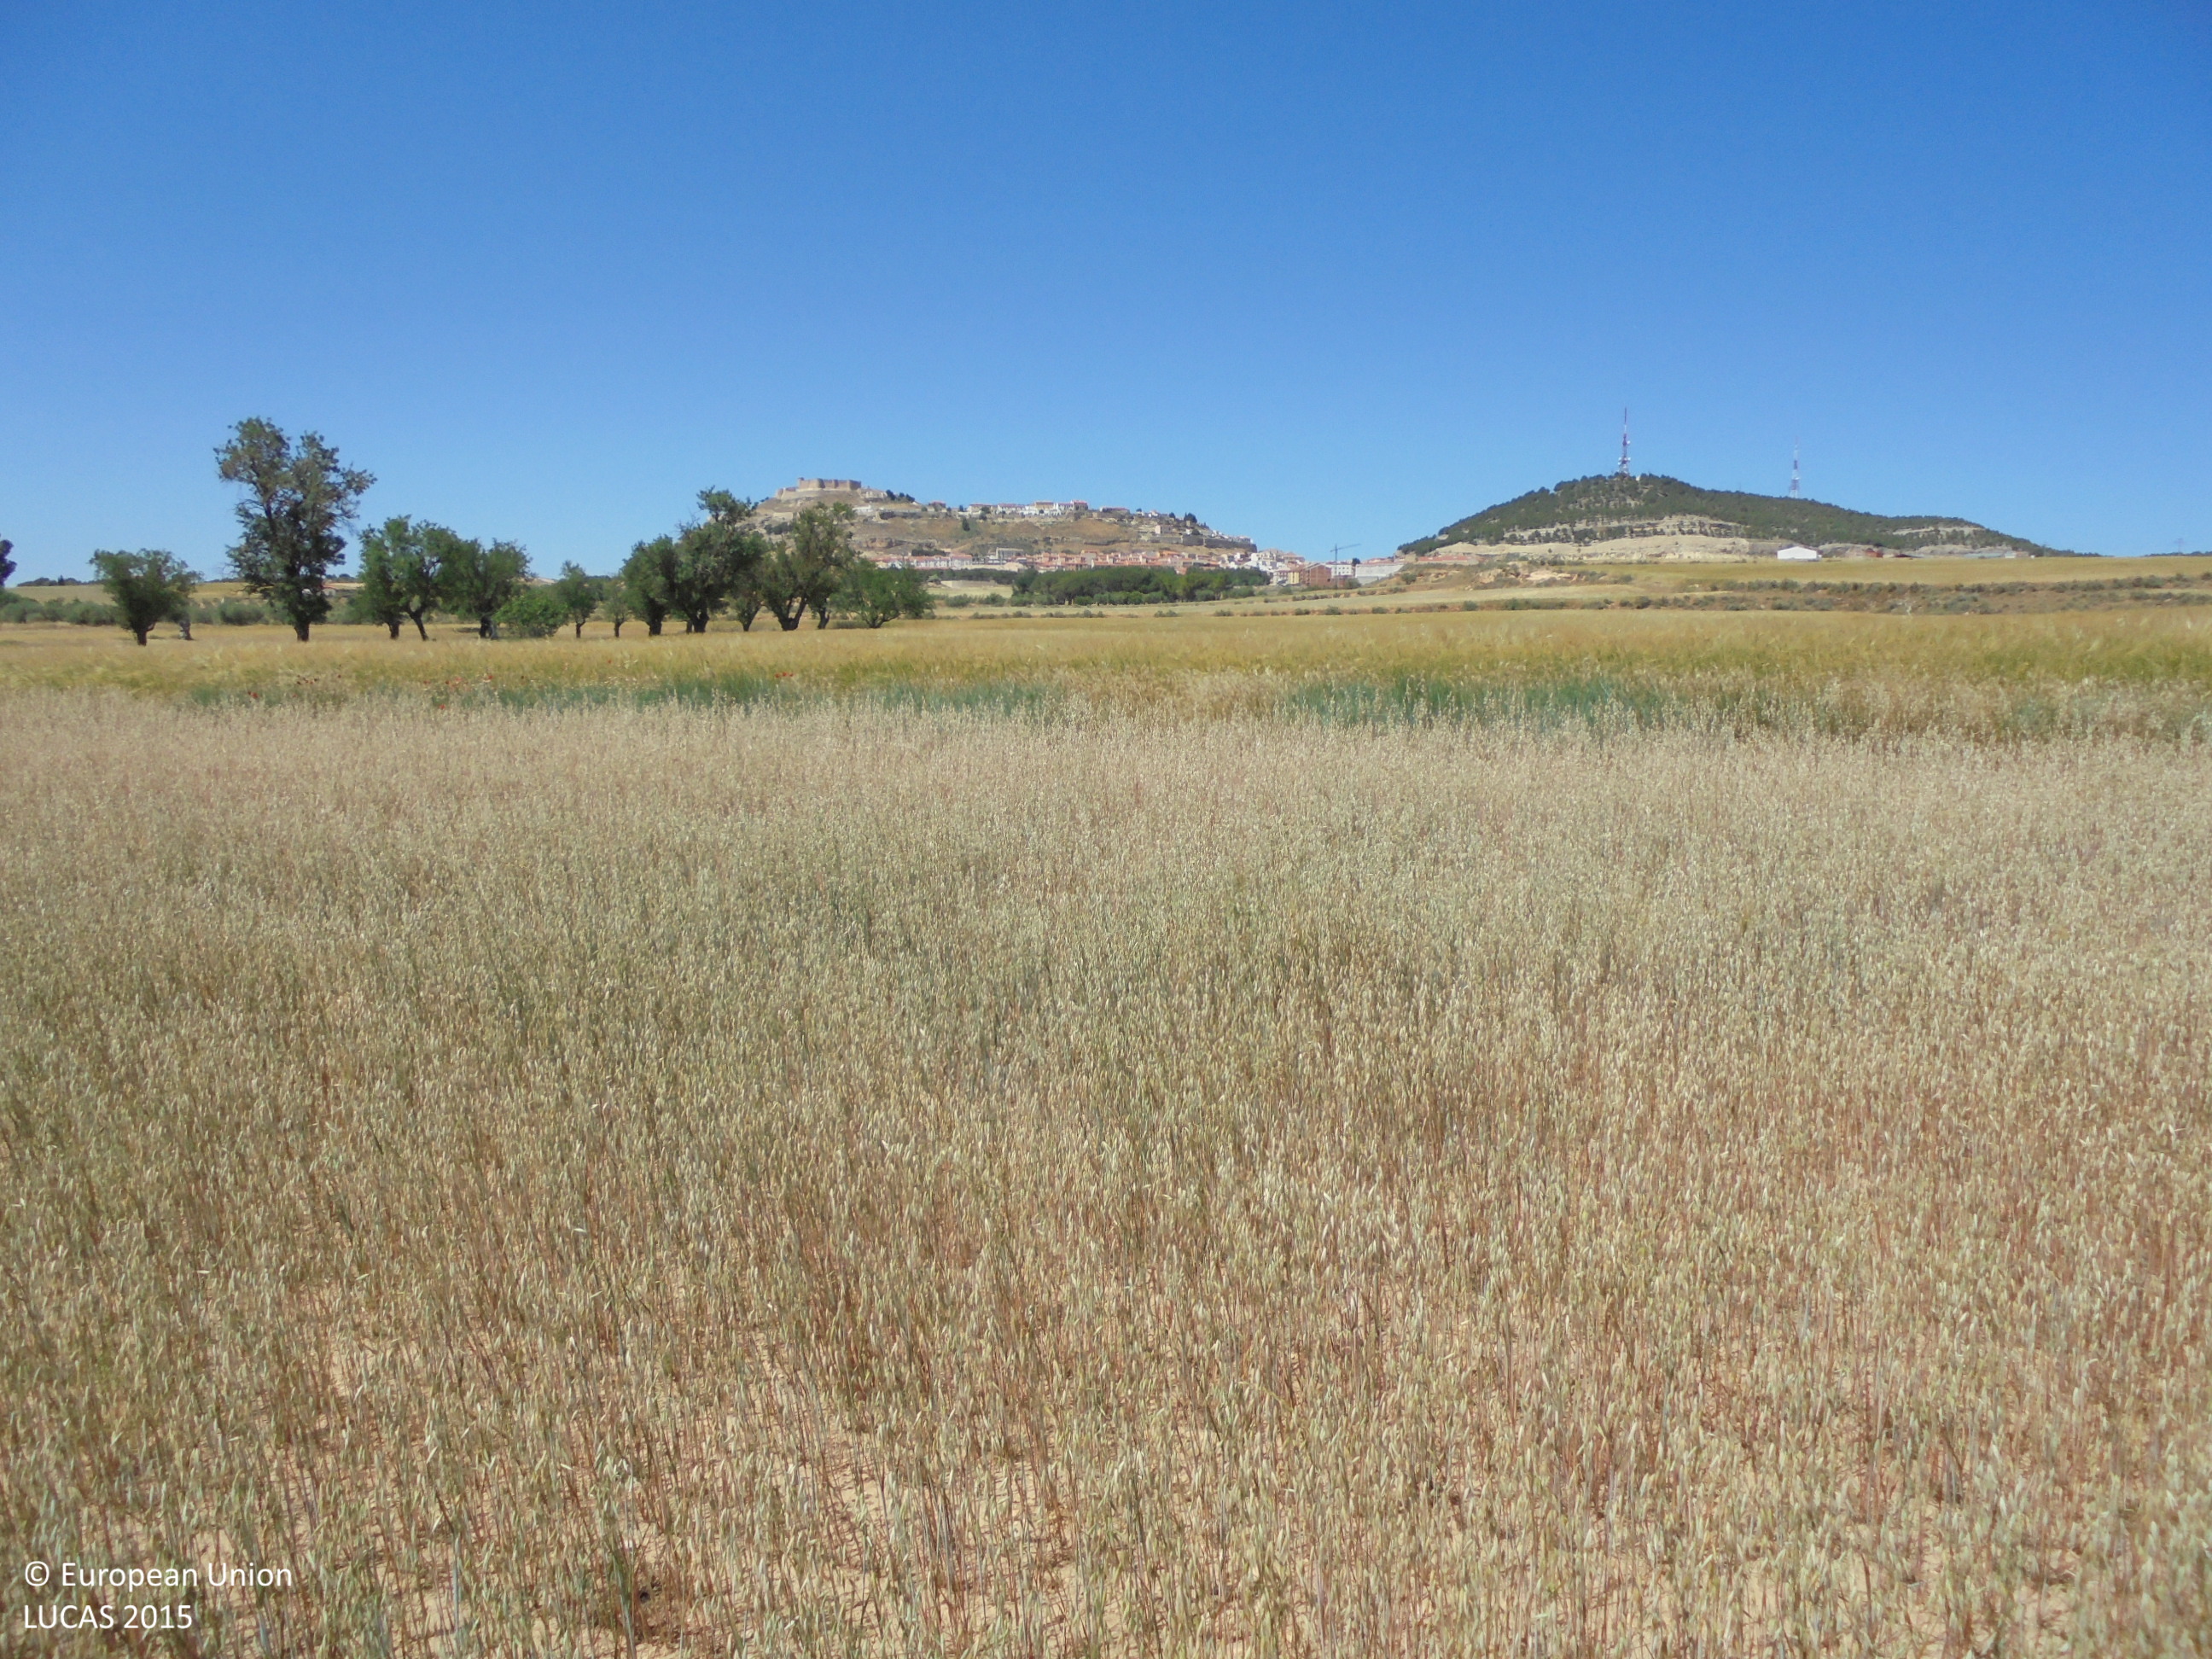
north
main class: Cropland
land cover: Oats
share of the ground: 25 - 50 %
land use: Agriculture (excluding fallow land and kitchen gardens)
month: May
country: ES
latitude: 38.9038
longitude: -1.7255
